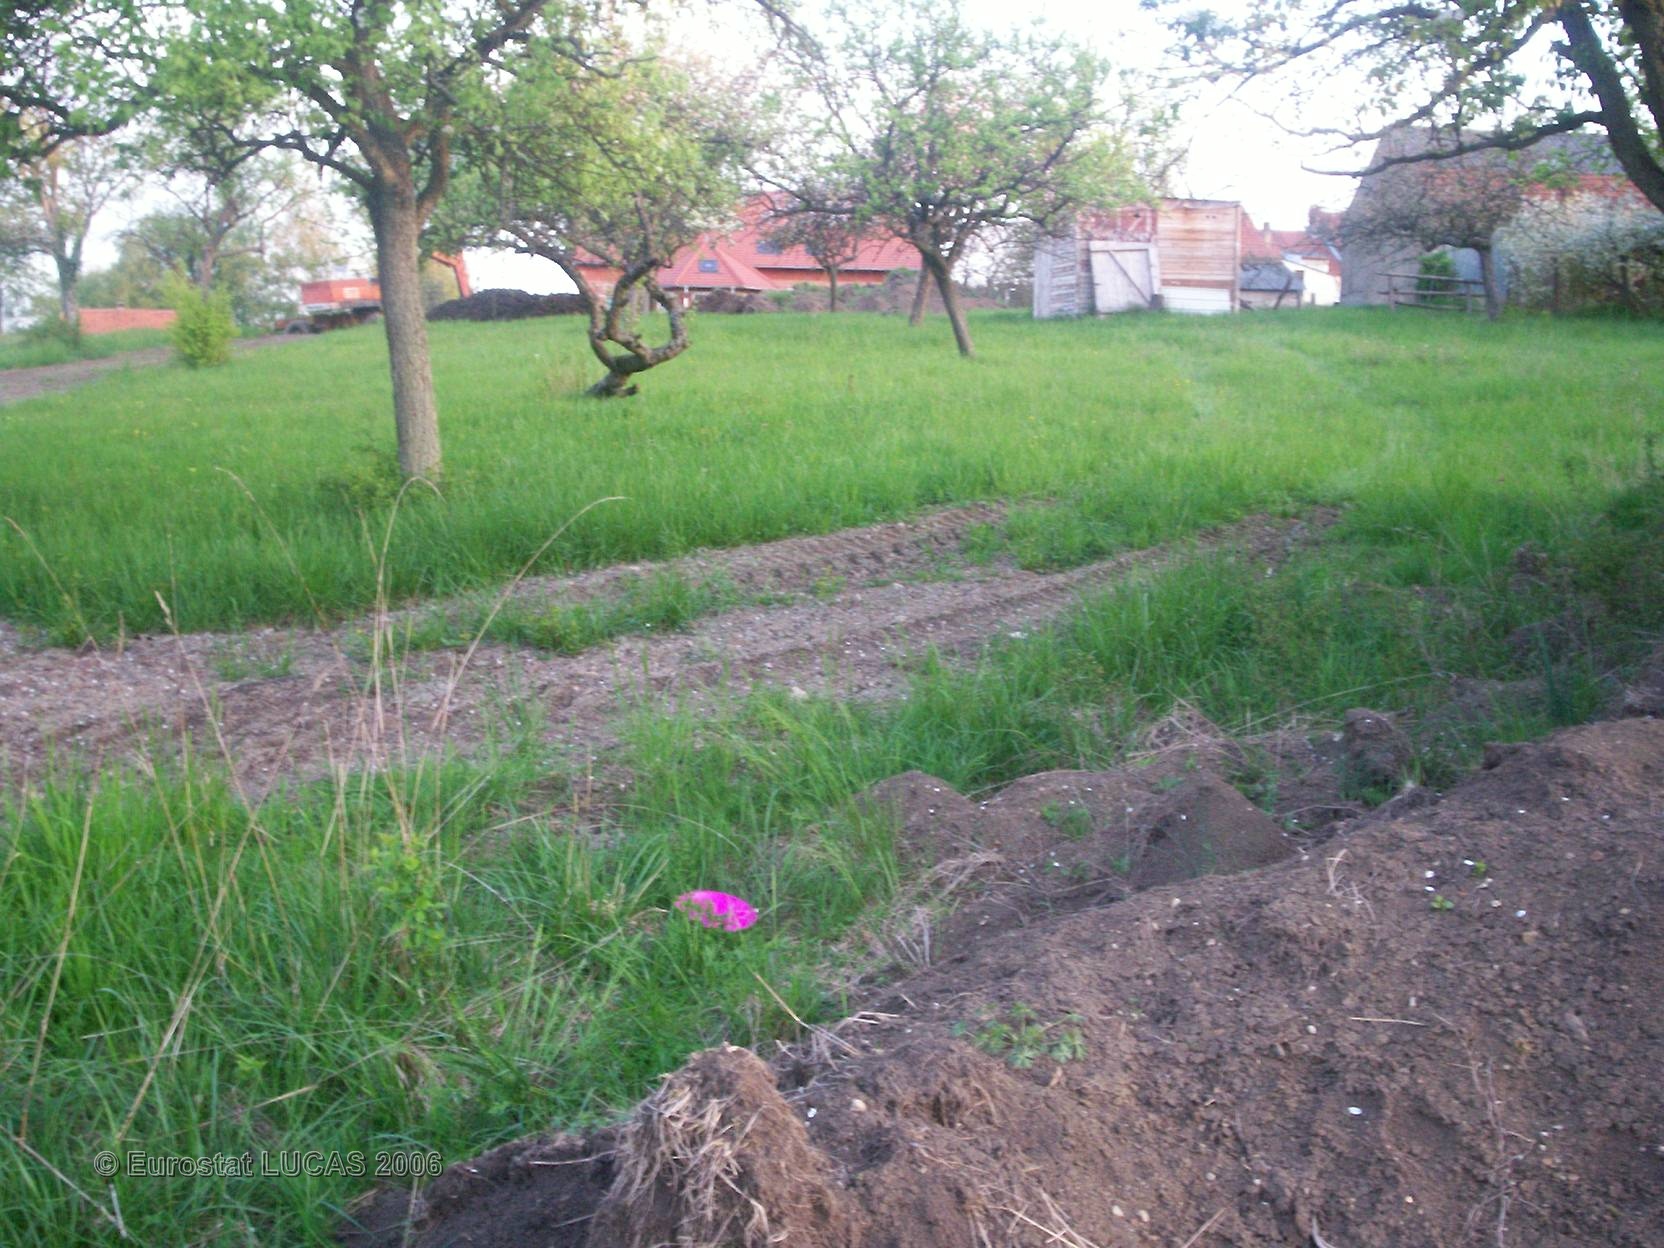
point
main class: Cropland
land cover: Apple fruit
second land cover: Grassland with sparse tree/shrub cover
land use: Agriculture (excluding fallow land and kitchen gardens)
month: May
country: FR
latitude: 49.0463
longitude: 6.9768
